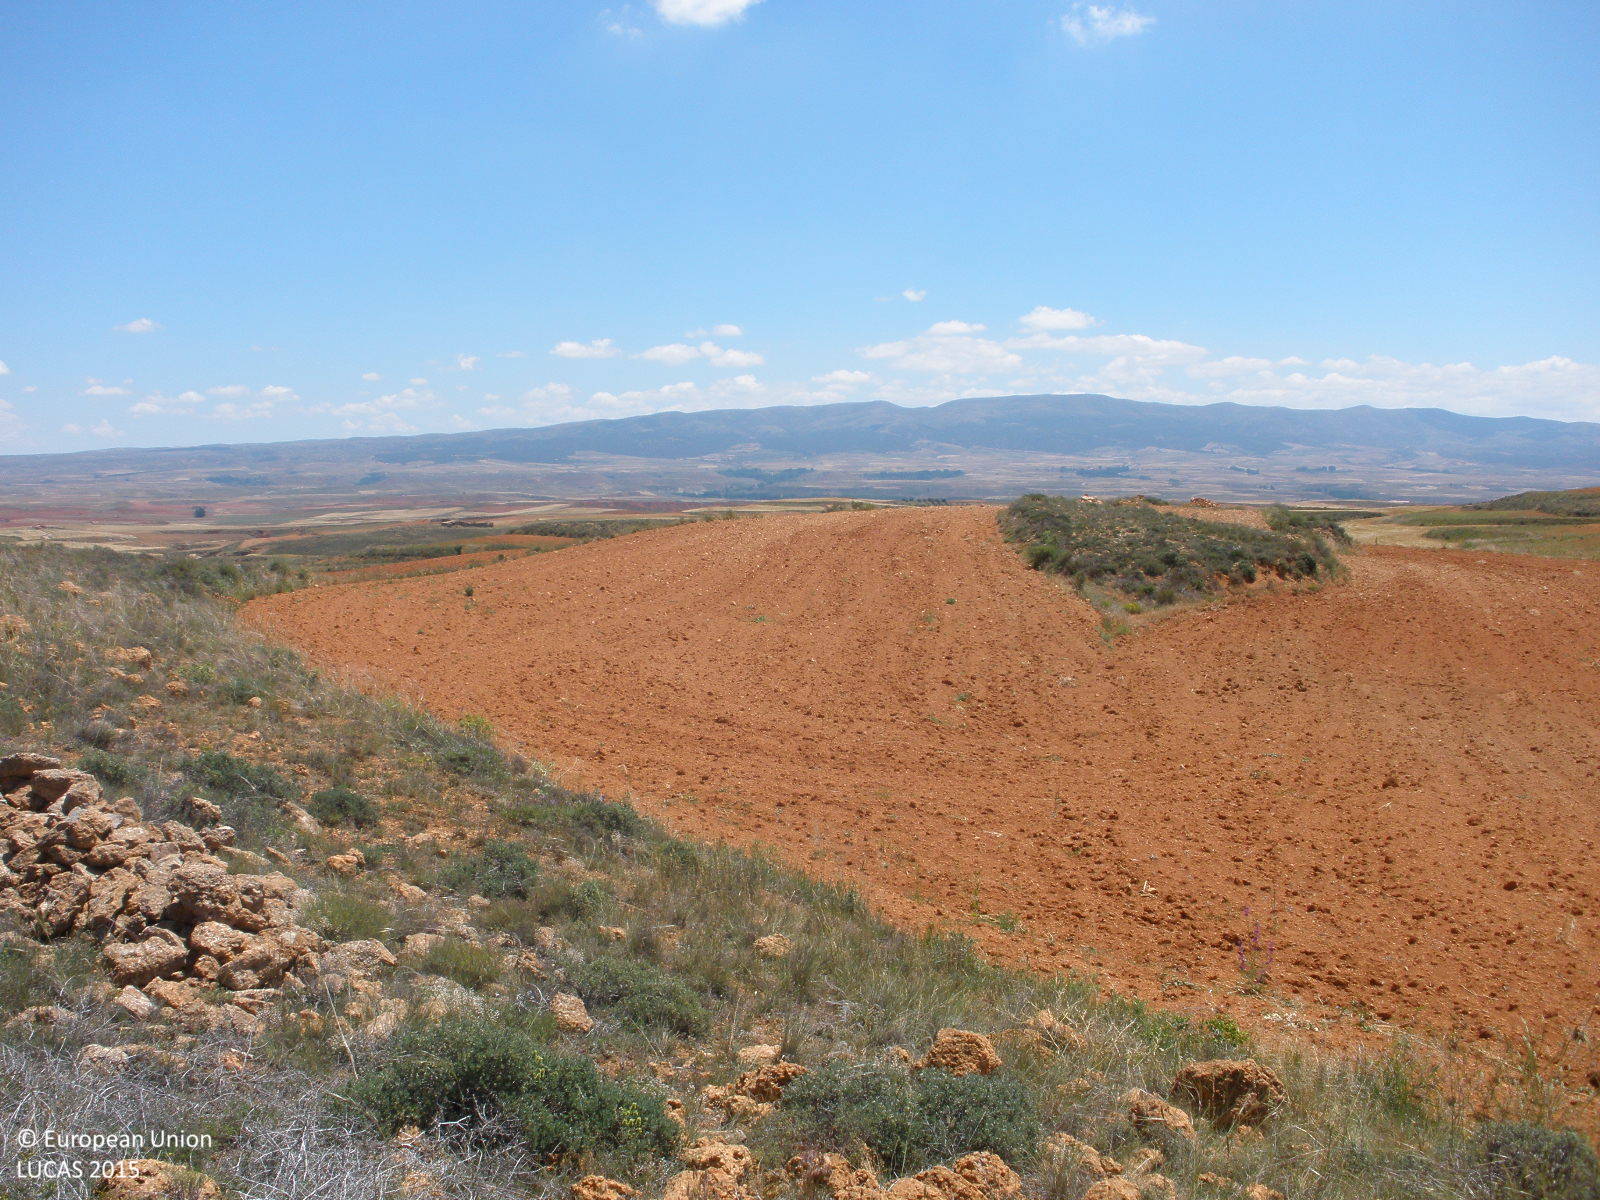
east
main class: Shrubland
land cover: Shrubland without tree cover
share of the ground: > 75 %
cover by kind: shrubs 75 %, consolidated bare surface 15 %, herbaceous plants 10 %
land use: Semi-natural and natural areas not in use
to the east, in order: Shrubland without tree cover; Other bare soil; Shrubland without tree cover; Other bare soil; Grass margins; Spontaneously vegetated surfaces
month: June
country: ES
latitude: 40.5680
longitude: -1.0803
